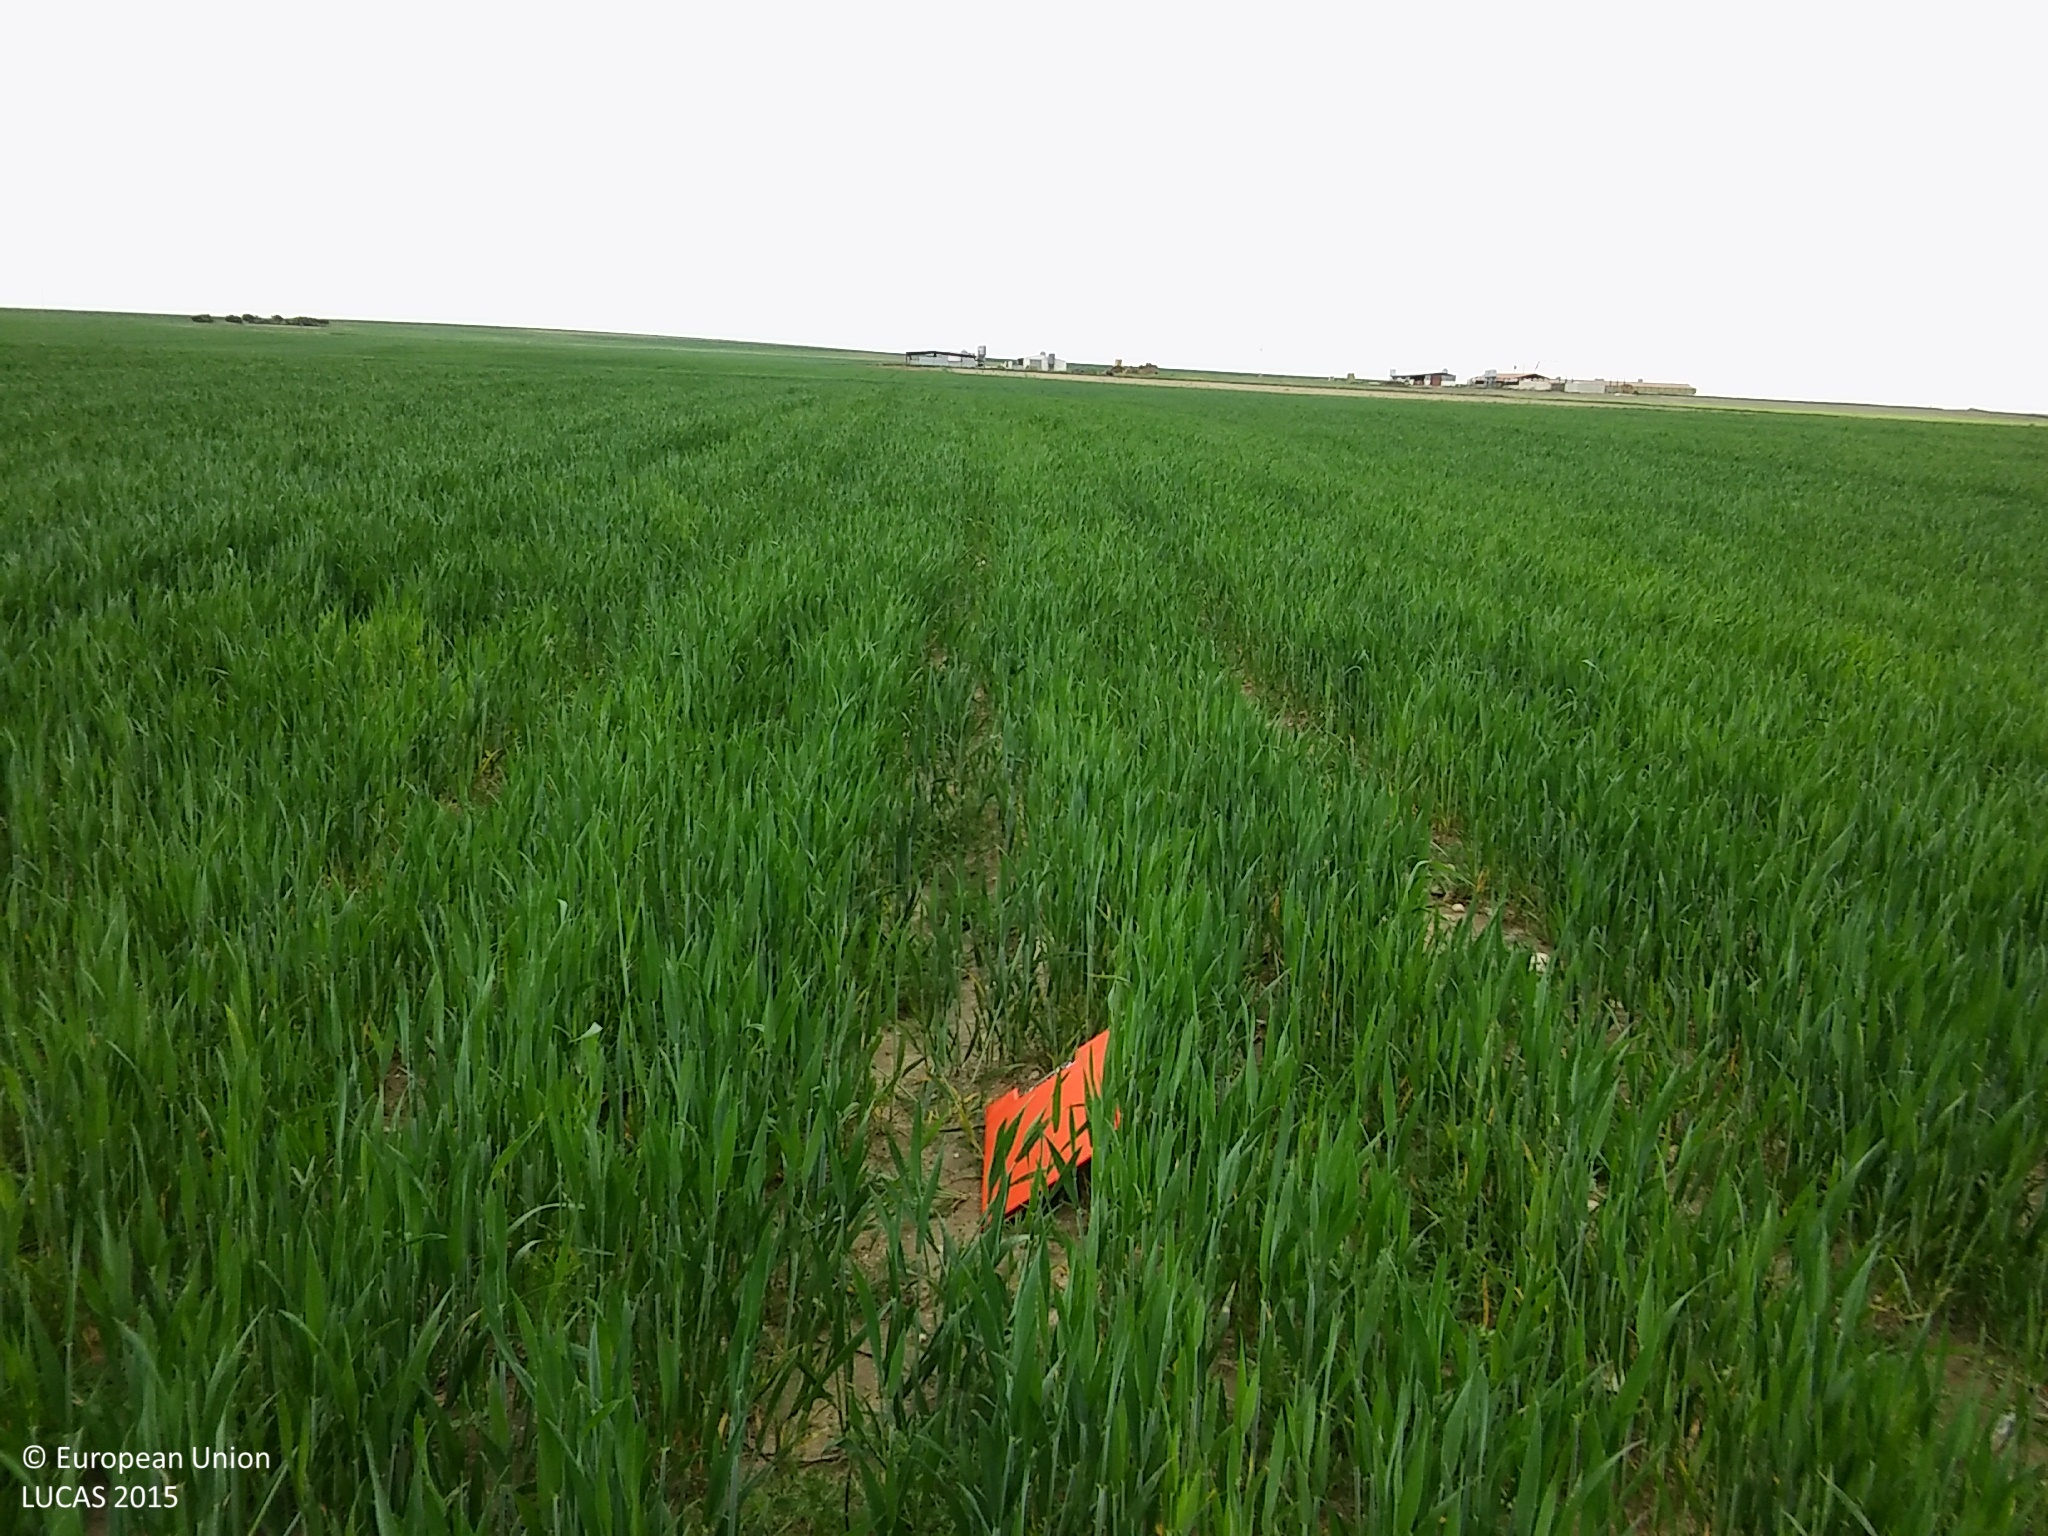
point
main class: Cropland
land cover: Common wheat
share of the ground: 50 - 75 %
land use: Agriculture (excluding fallow land and kitchen gardens)
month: May
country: ES
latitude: 41.1559
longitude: -4.0540
